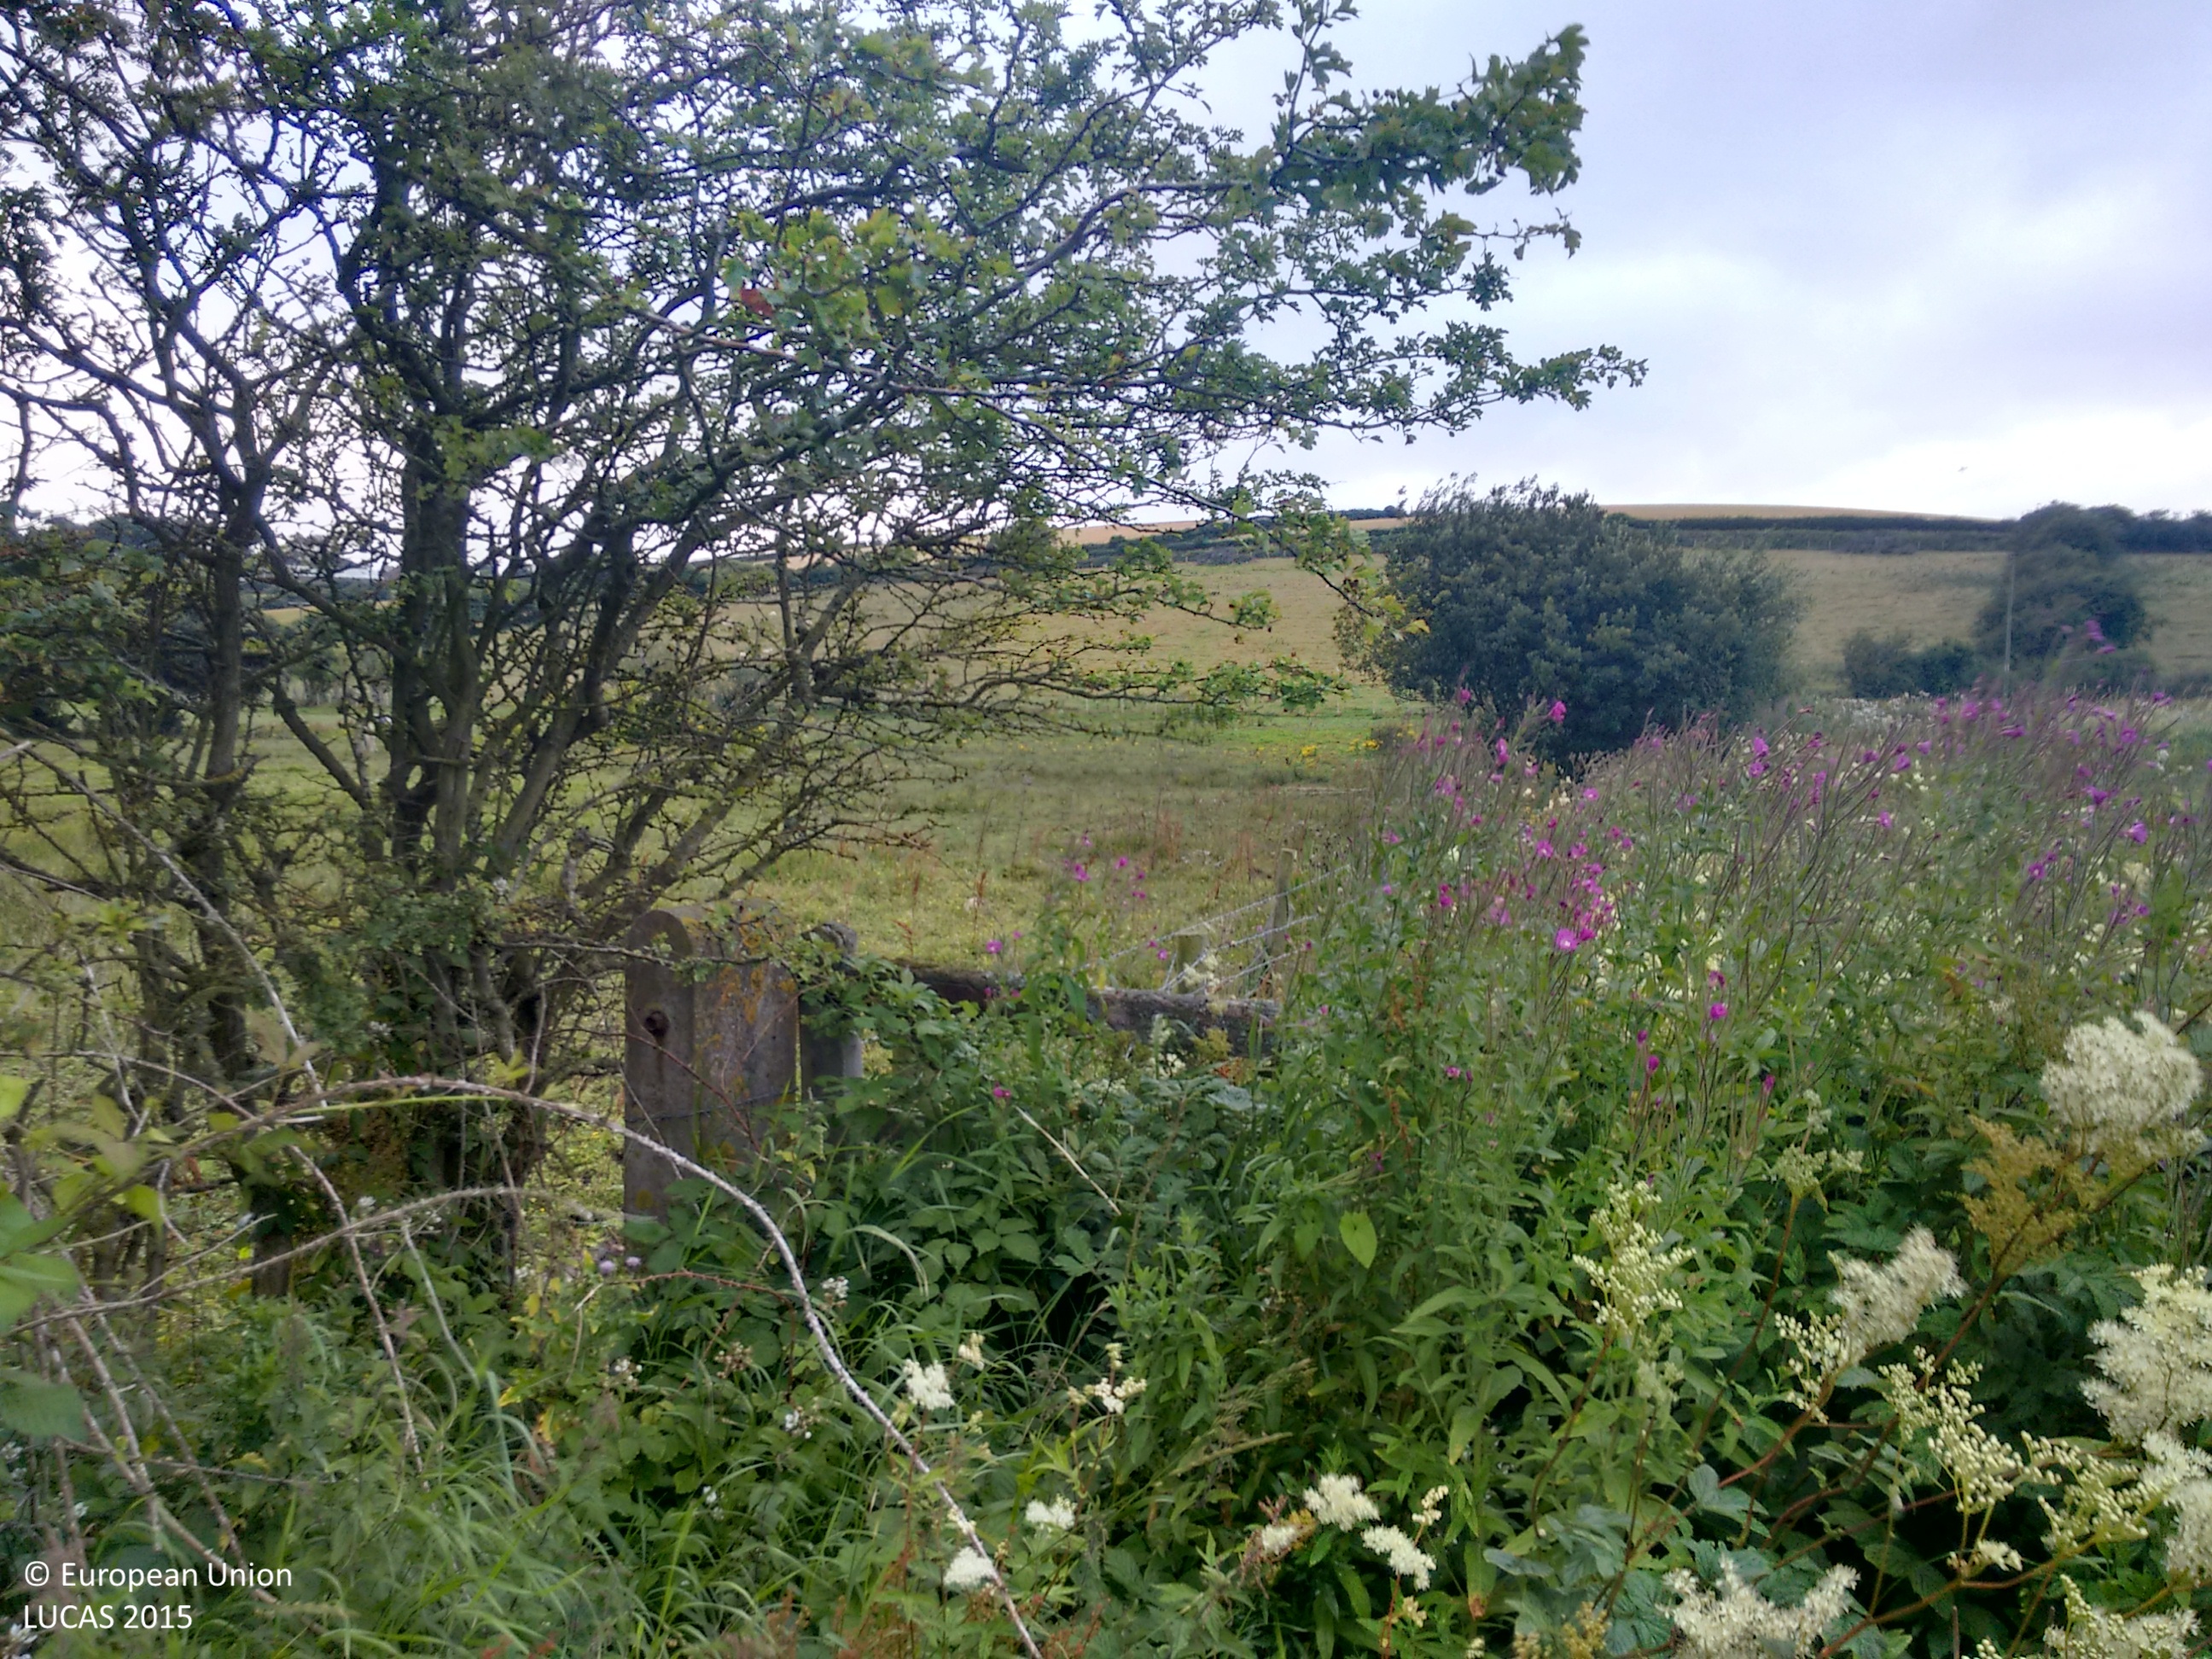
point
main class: Grassland
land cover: Grassland without tree/shrub cover
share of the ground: > 75 %
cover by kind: herbaceous plants 100 %
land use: Agriculture (excluding fallow land and kitchen gardens)
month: August
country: GB
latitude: 54.7236
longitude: -3.4802
